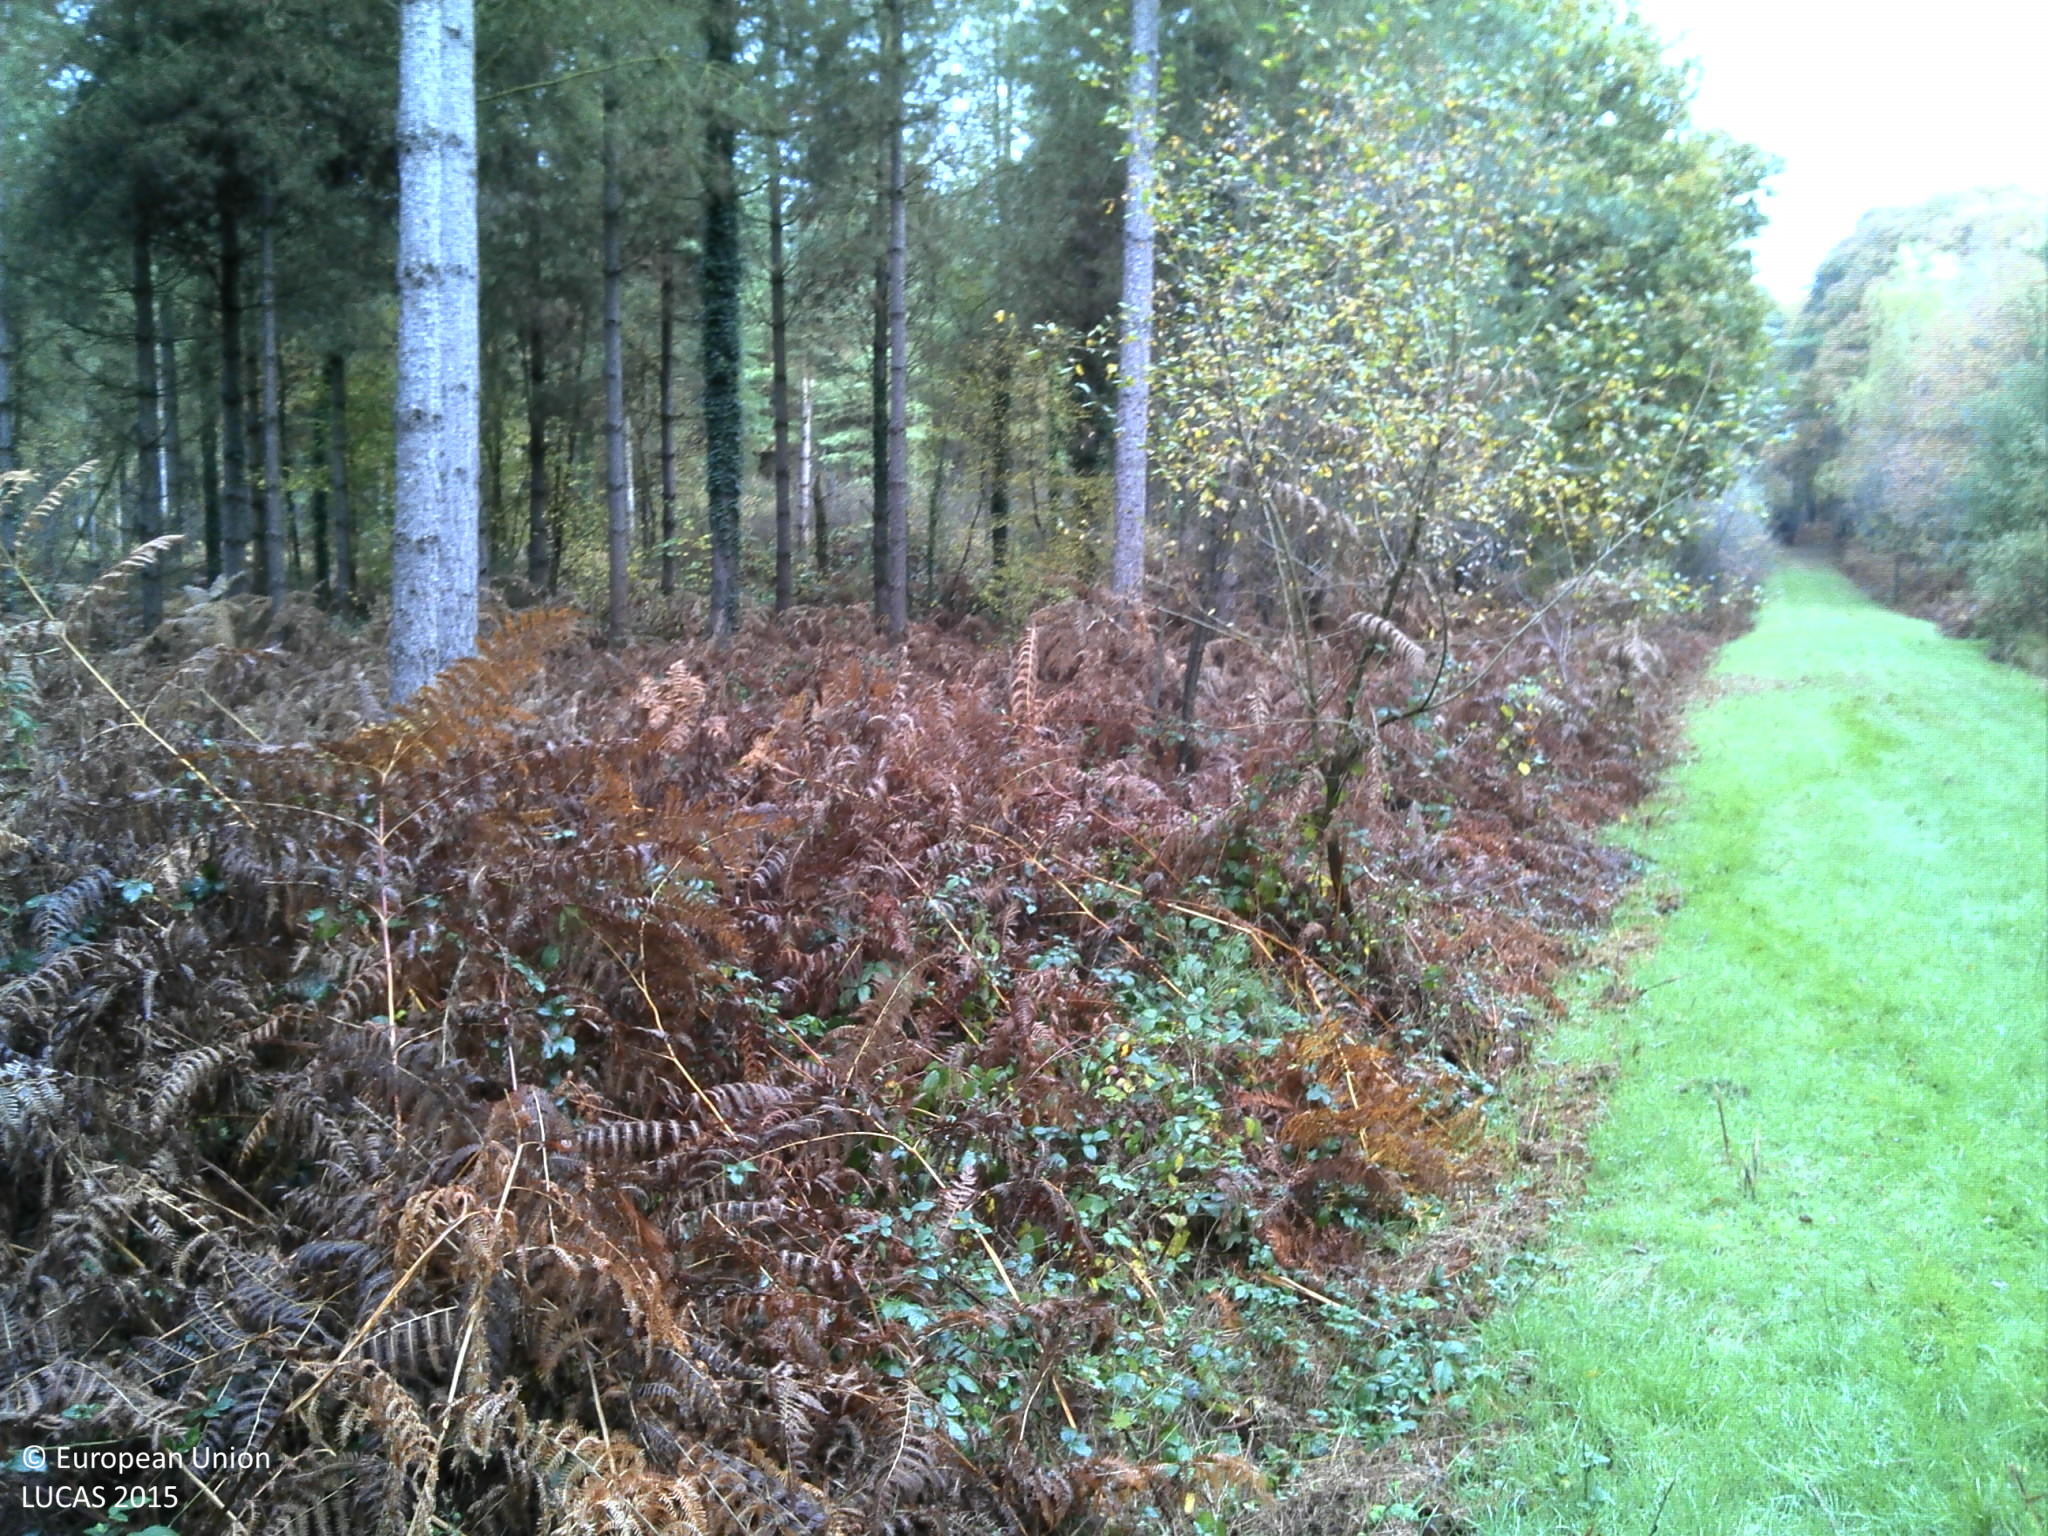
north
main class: Woodland
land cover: Pine dominated coniferous woodland
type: exotic forest
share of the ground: > 75 %
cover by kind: coniferous forest trees 85 %, herbaceous plants 15 %
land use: Forestry
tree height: > 5 m
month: November
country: FR
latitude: 47.6878
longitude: -1.5417
